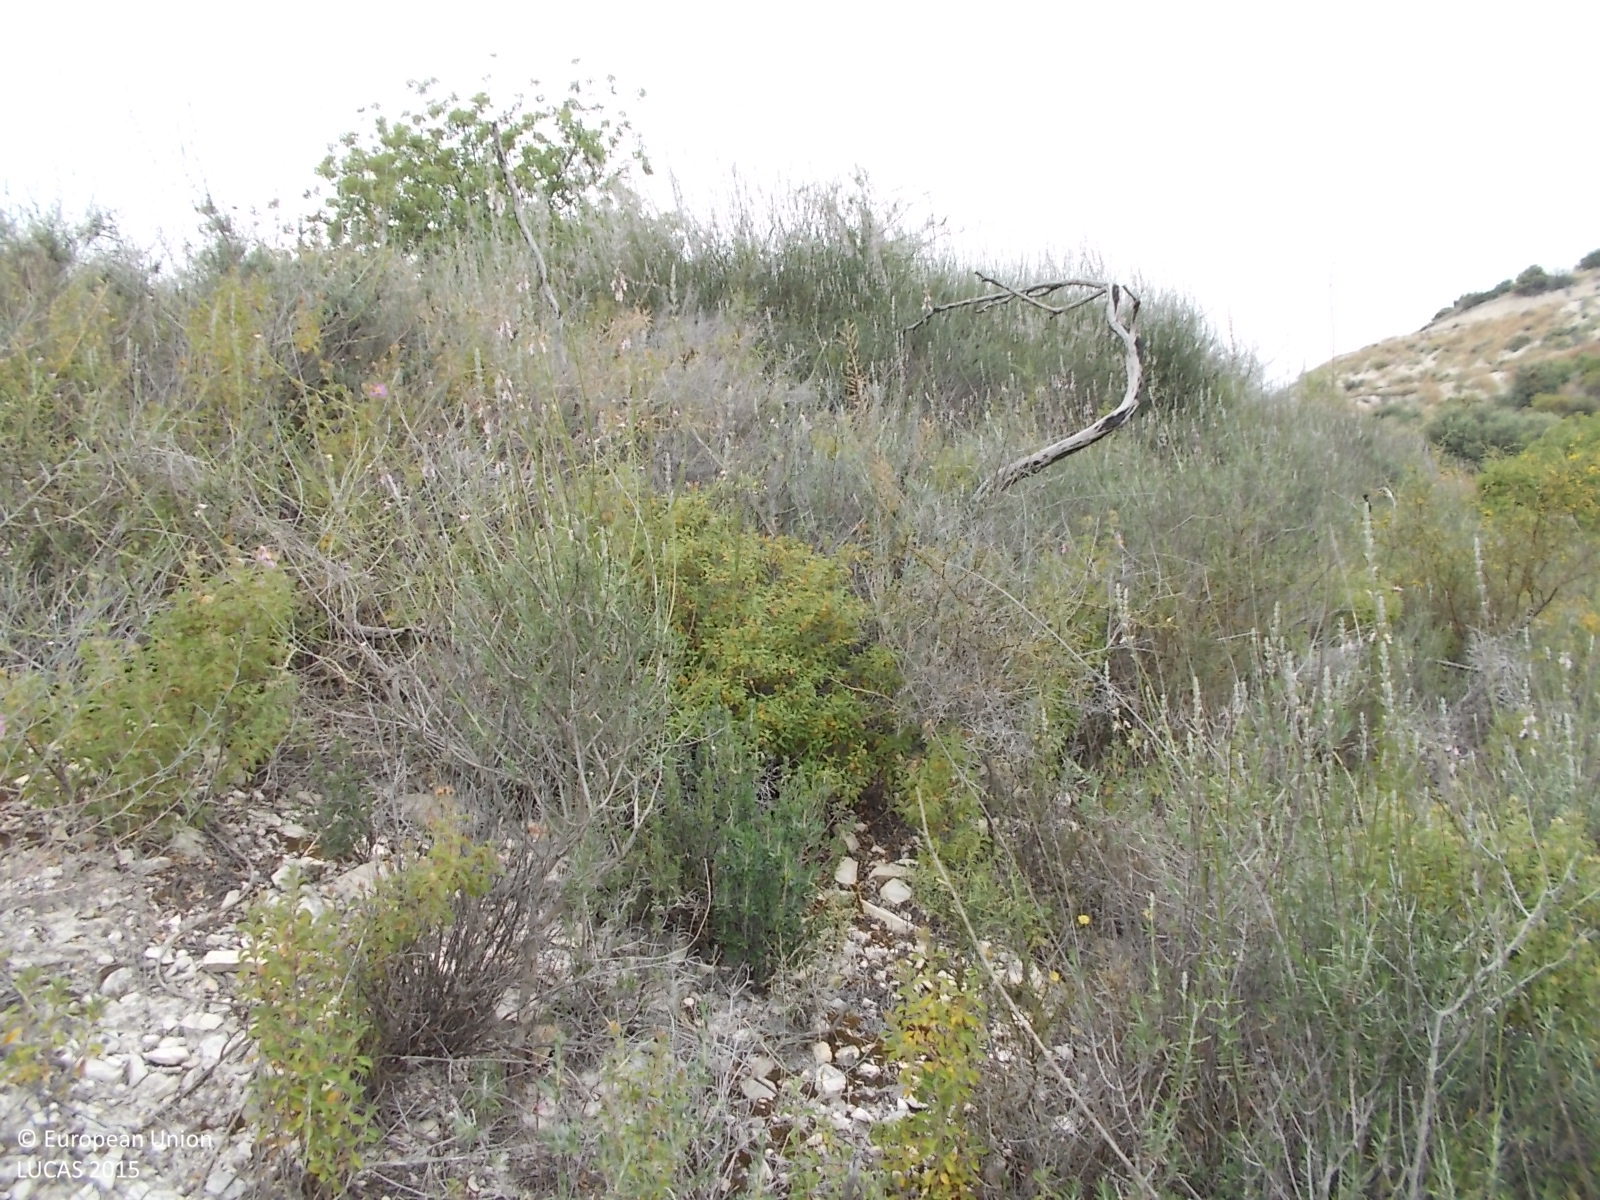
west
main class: Shrubland
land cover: Shrubland without tree cover
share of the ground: > 75 %
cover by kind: shrubs 90 %, unconsolidated bare surface 10 %
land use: Semi-natural and natural areas not in use
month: May
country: CY
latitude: 34.7814
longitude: 33.2674
